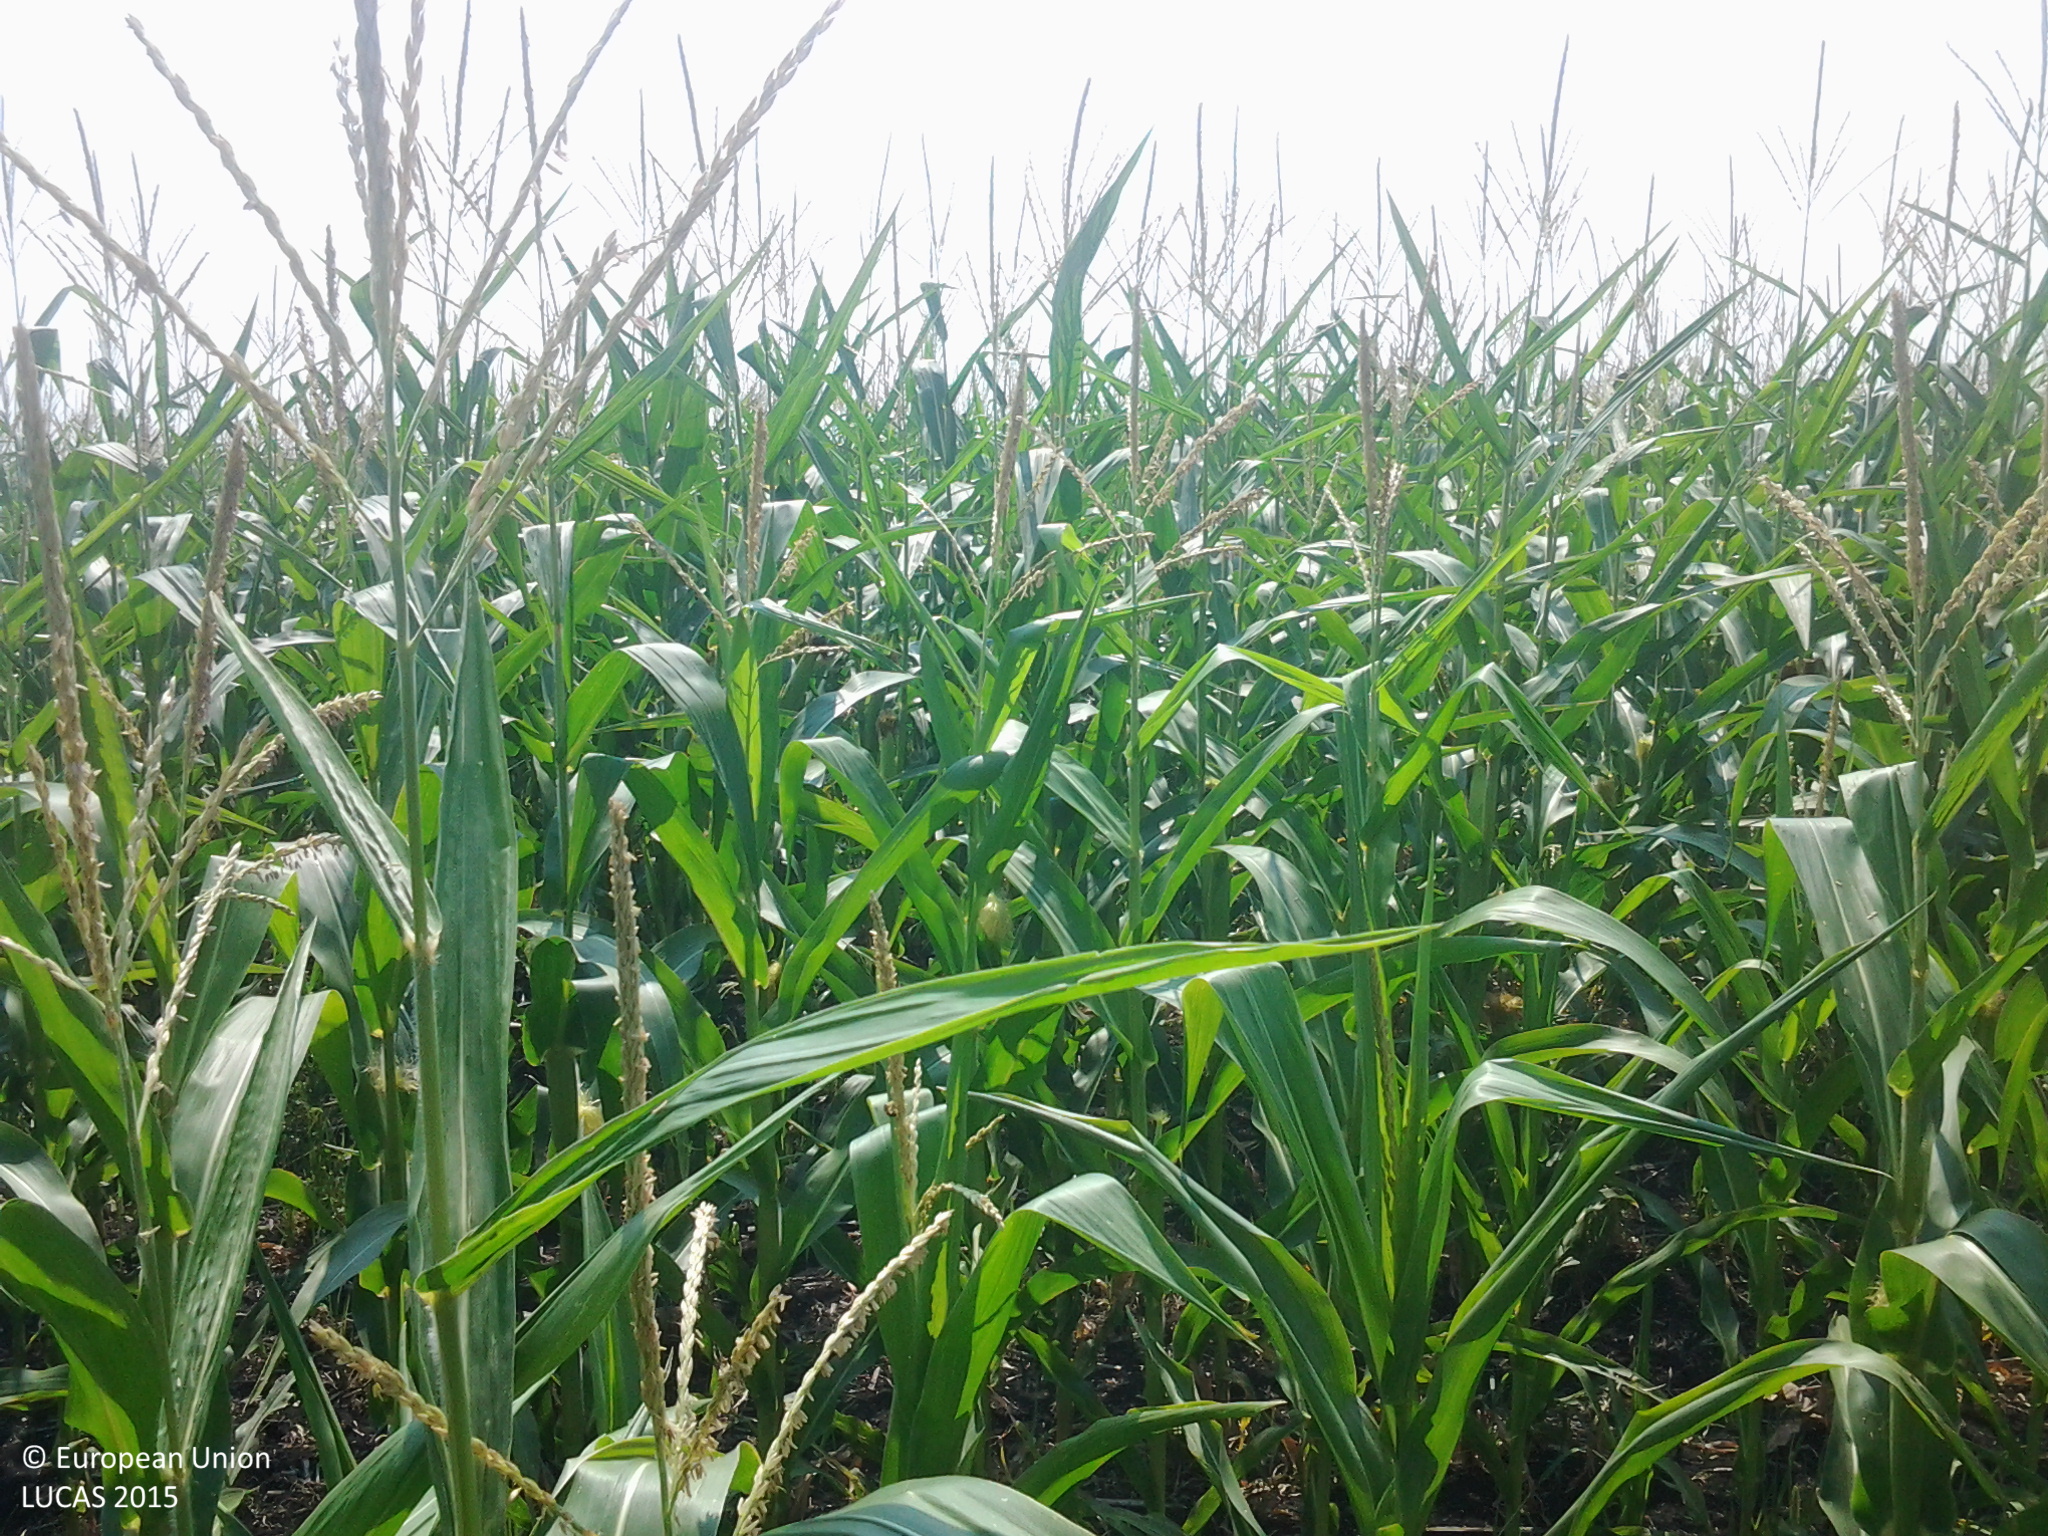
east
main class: Cropland
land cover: Maize
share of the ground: > 75 %
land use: Agriculture (excluding fallow land and kitchen gardens)
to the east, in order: Maize; Grassland without tree/shrub cover; Common wheat; Grassland without tree/shrub cover; Maize
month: July
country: HU
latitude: 47.5507
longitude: 20.5694
